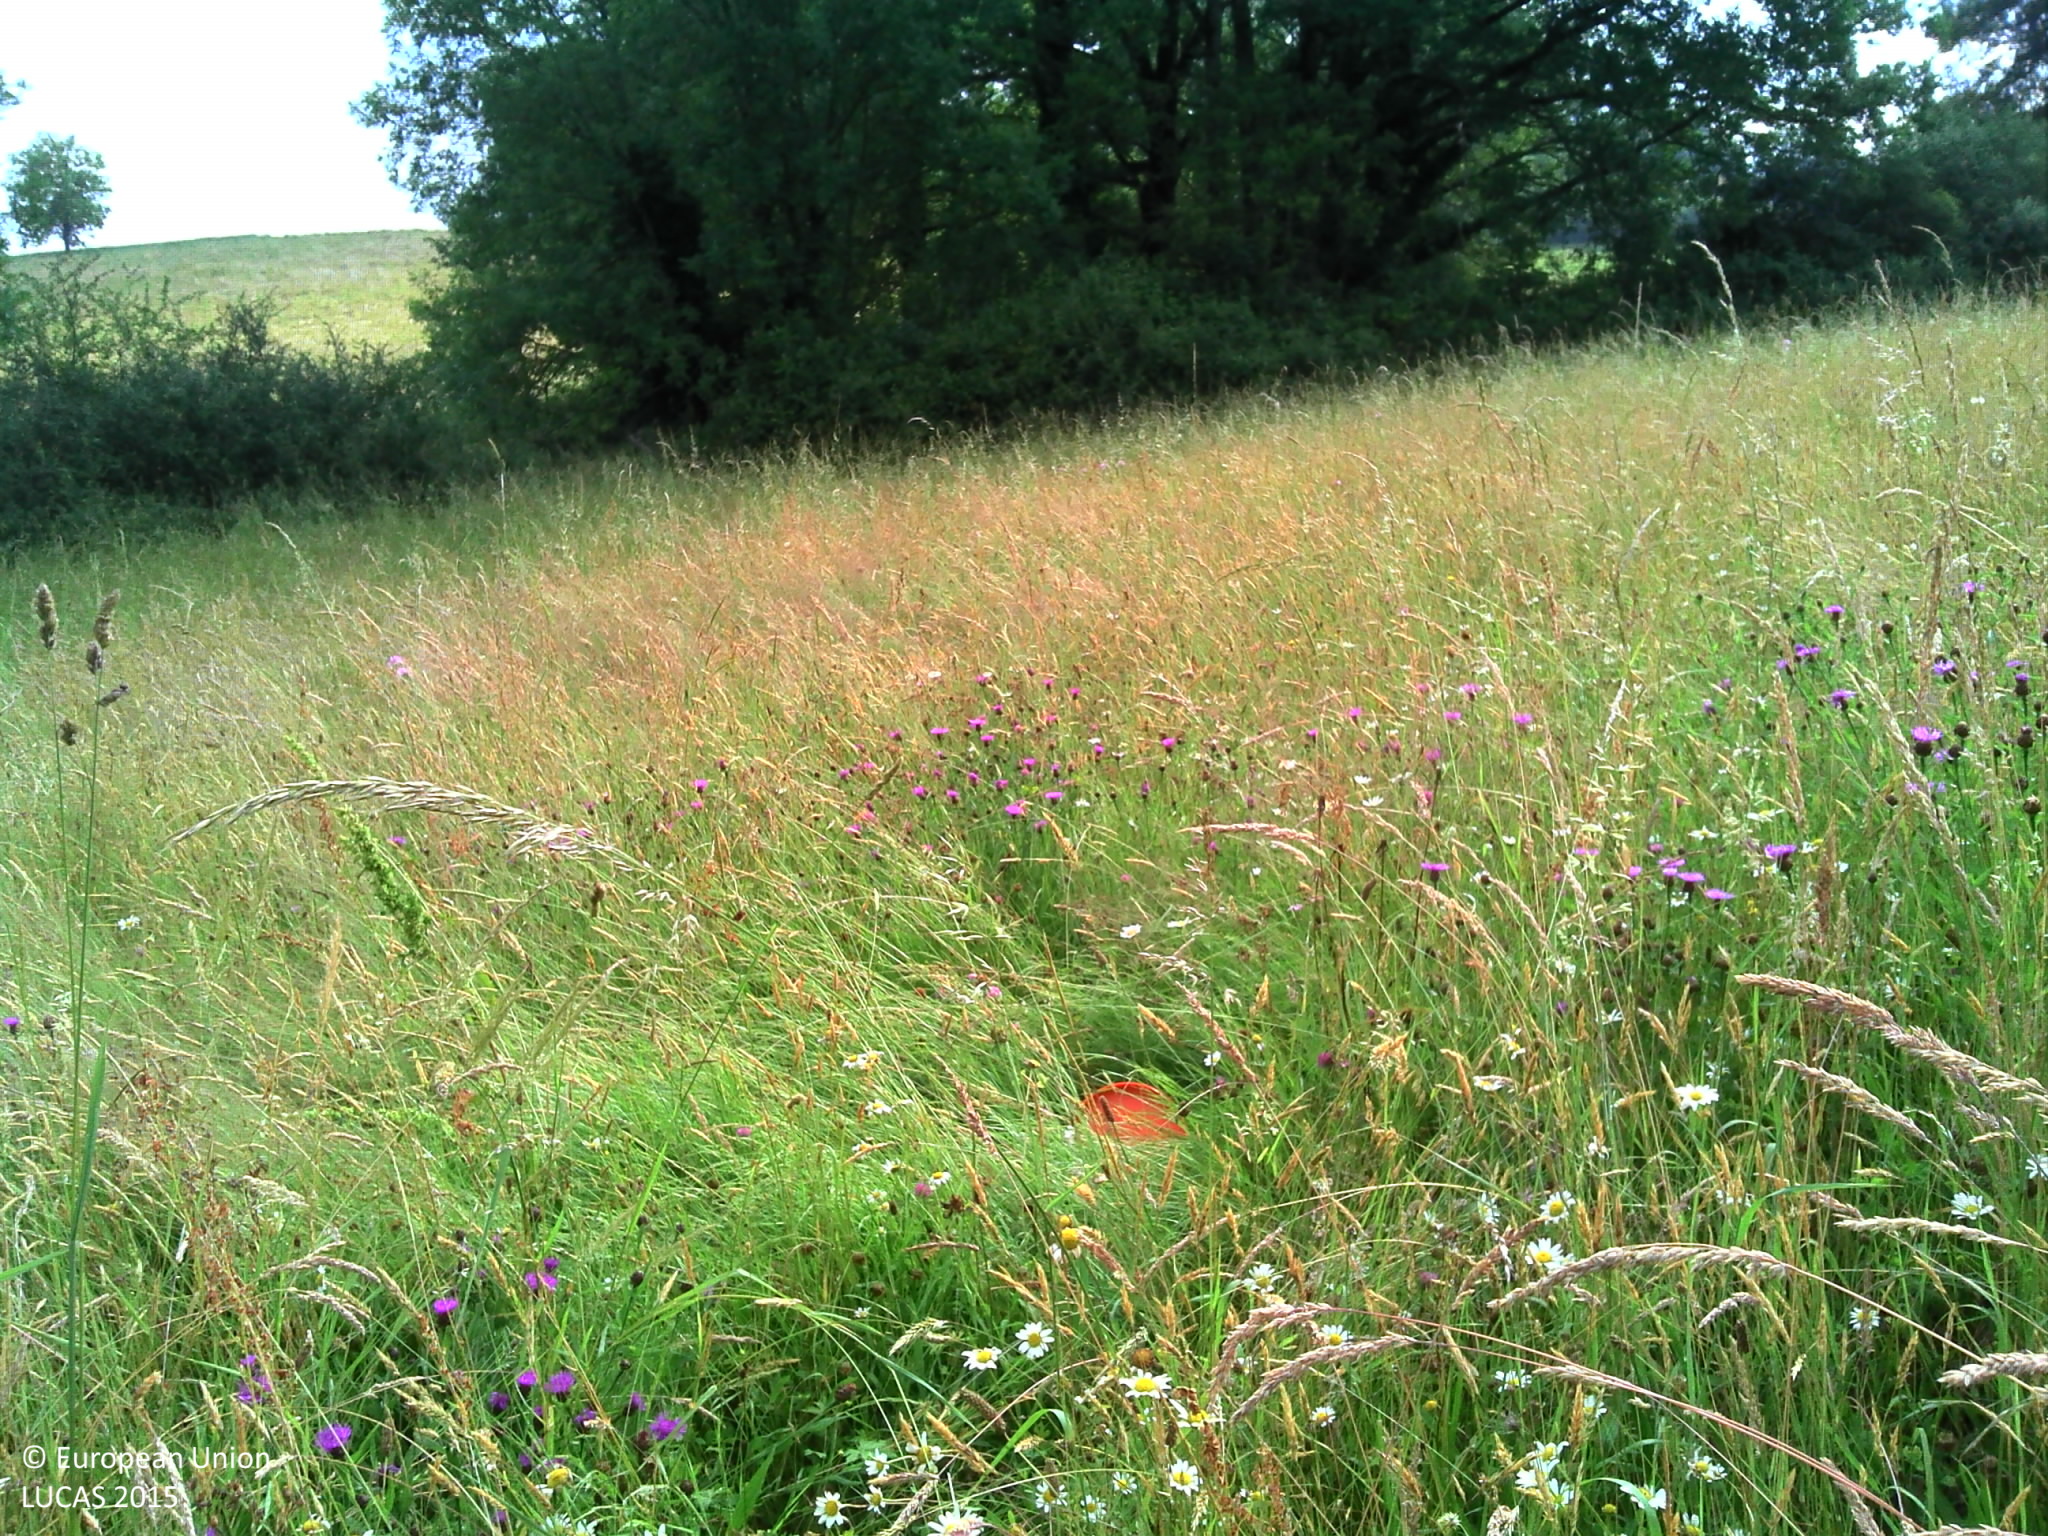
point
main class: Grassland
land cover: Grassland without tree/shrub cover
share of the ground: > 75 %
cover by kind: herbaceous plants 100 %
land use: Agriculture (excluding fallow land and kitchen gardens)
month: June
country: FR
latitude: 44.2087
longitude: 2.0552
